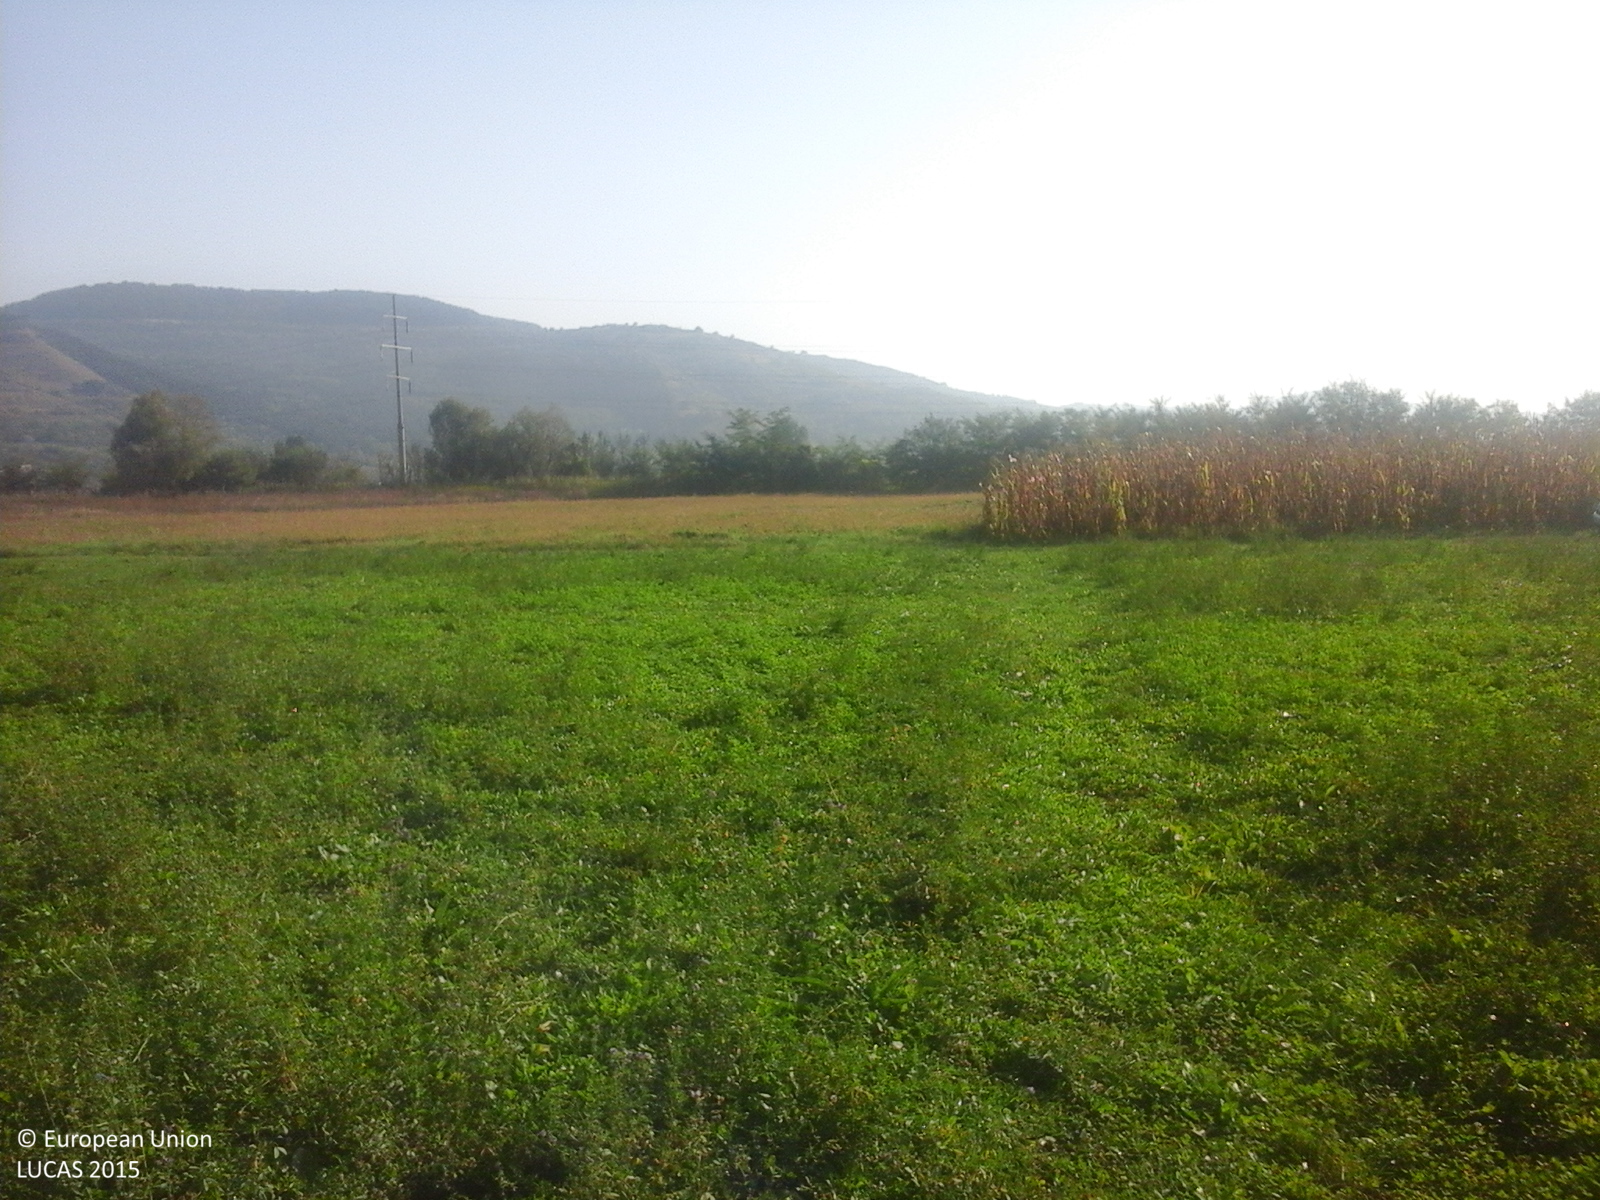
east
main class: Cropland
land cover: Other leguminous and mixtures for fodder
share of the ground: > 75 %
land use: Agriculture (excluding fallow land and kitchen gardens)
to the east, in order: Other leguminous and mixtures for fodder; Tracks; Maize; Abandoned hedges; Rivers and streams; Abandoned hedges; Maize; Electric lines; Maize; Tracks; Grass margins; Fences; Other fruit trees and berries; Fences; Grassland without tree/shrub cover
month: September
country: RO
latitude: 47.0229
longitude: 23.9331
